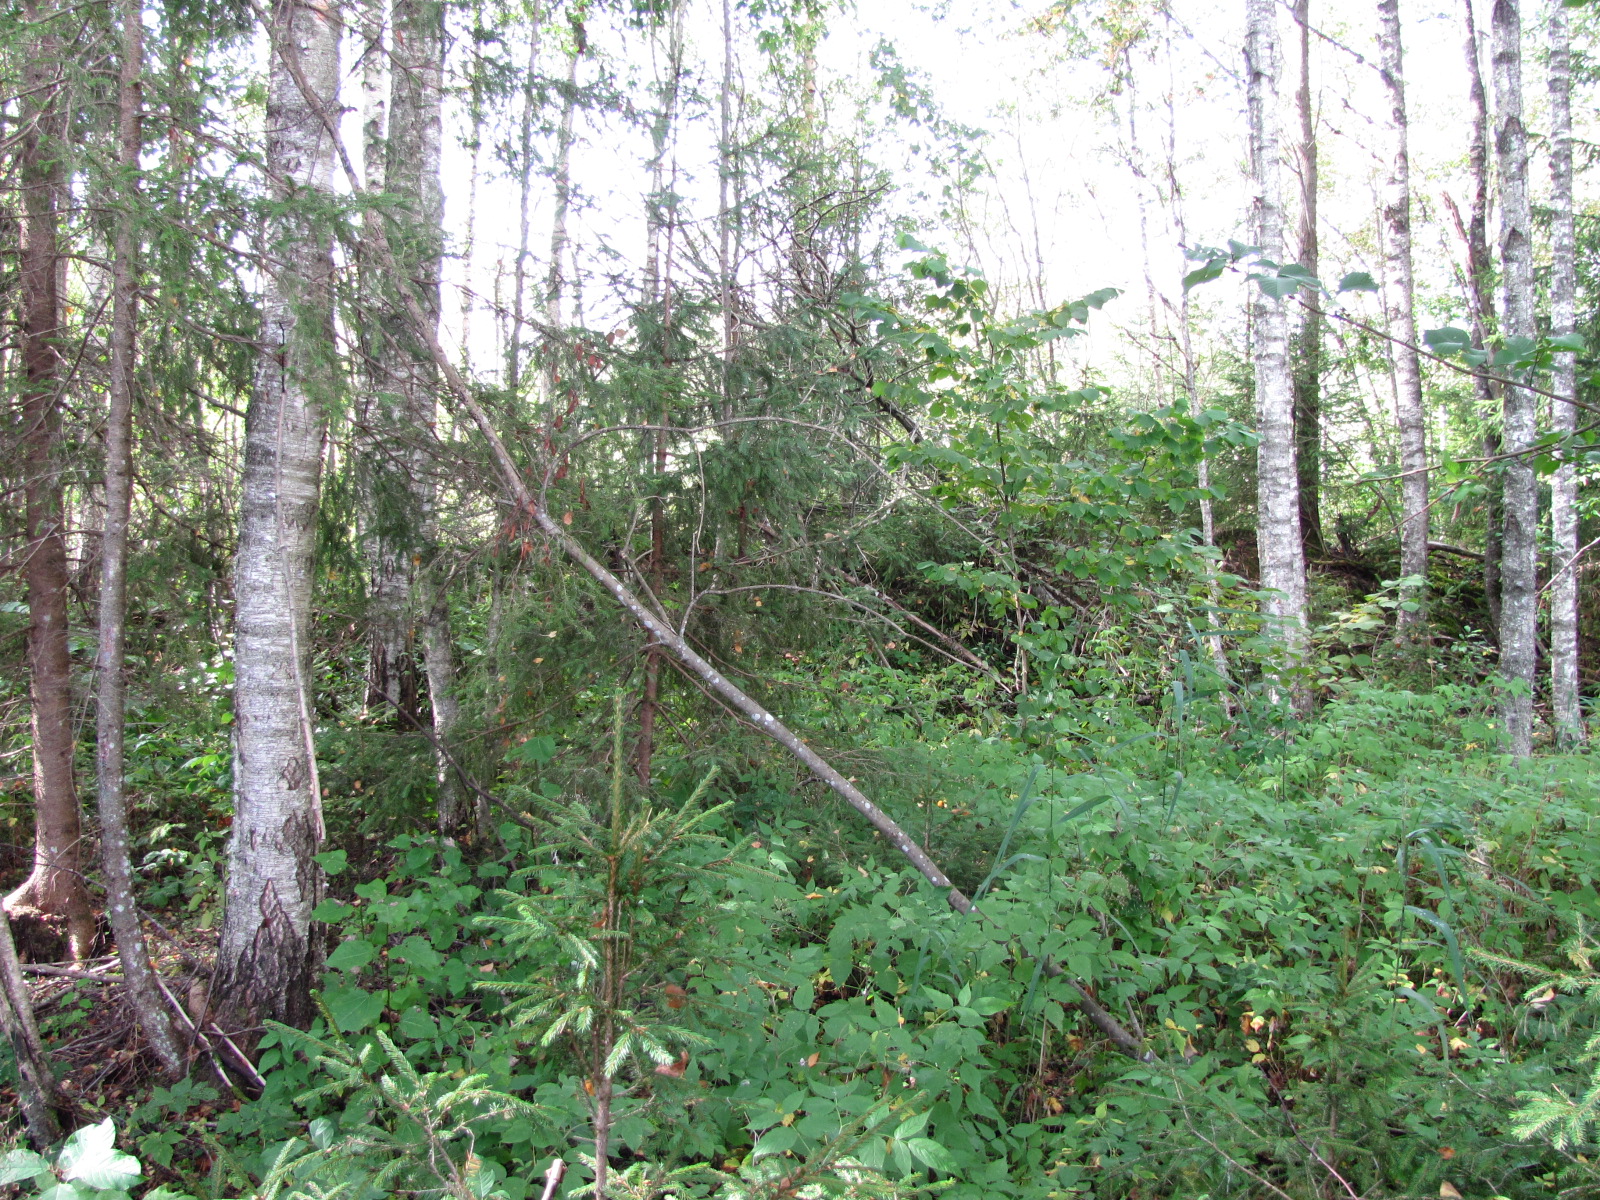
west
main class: Woodland
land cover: Spruce dominated mixed woodland
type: hemiboreal forest and nemoral coniferous forest and mixed broadleaved-coniferous forest
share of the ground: > 75 %
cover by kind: broadleaved forest trees 50 %, coniferous forest trees 30 %, herbaceous plants 15 %, lichens and mosses 5 %
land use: Forestry
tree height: > 5 m
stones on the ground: < 10 %
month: August
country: LV
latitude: 56.9203
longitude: 25.2414
